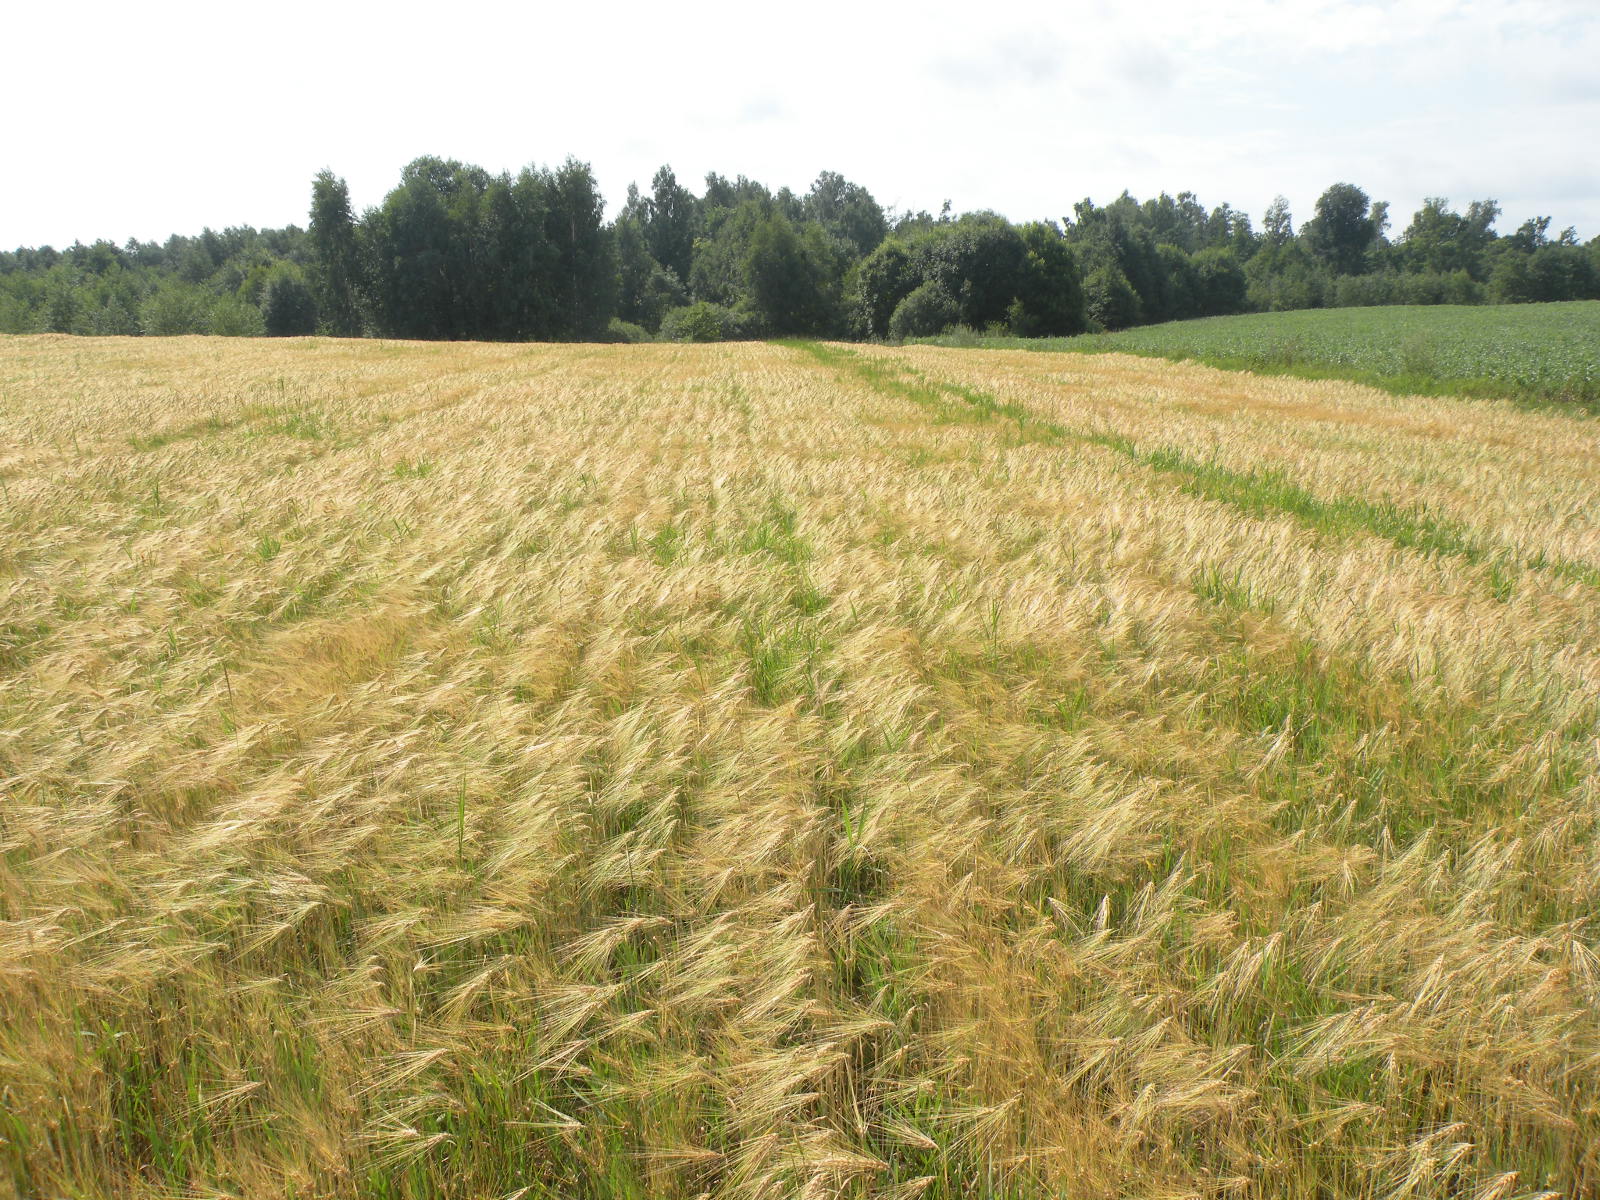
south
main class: Cropland
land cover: Barley
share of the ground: > 75 %
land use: Agriculture (excluding fallow land and kitchen gardens)
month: July
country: LV
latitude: 55.8518
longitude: 26.7220
